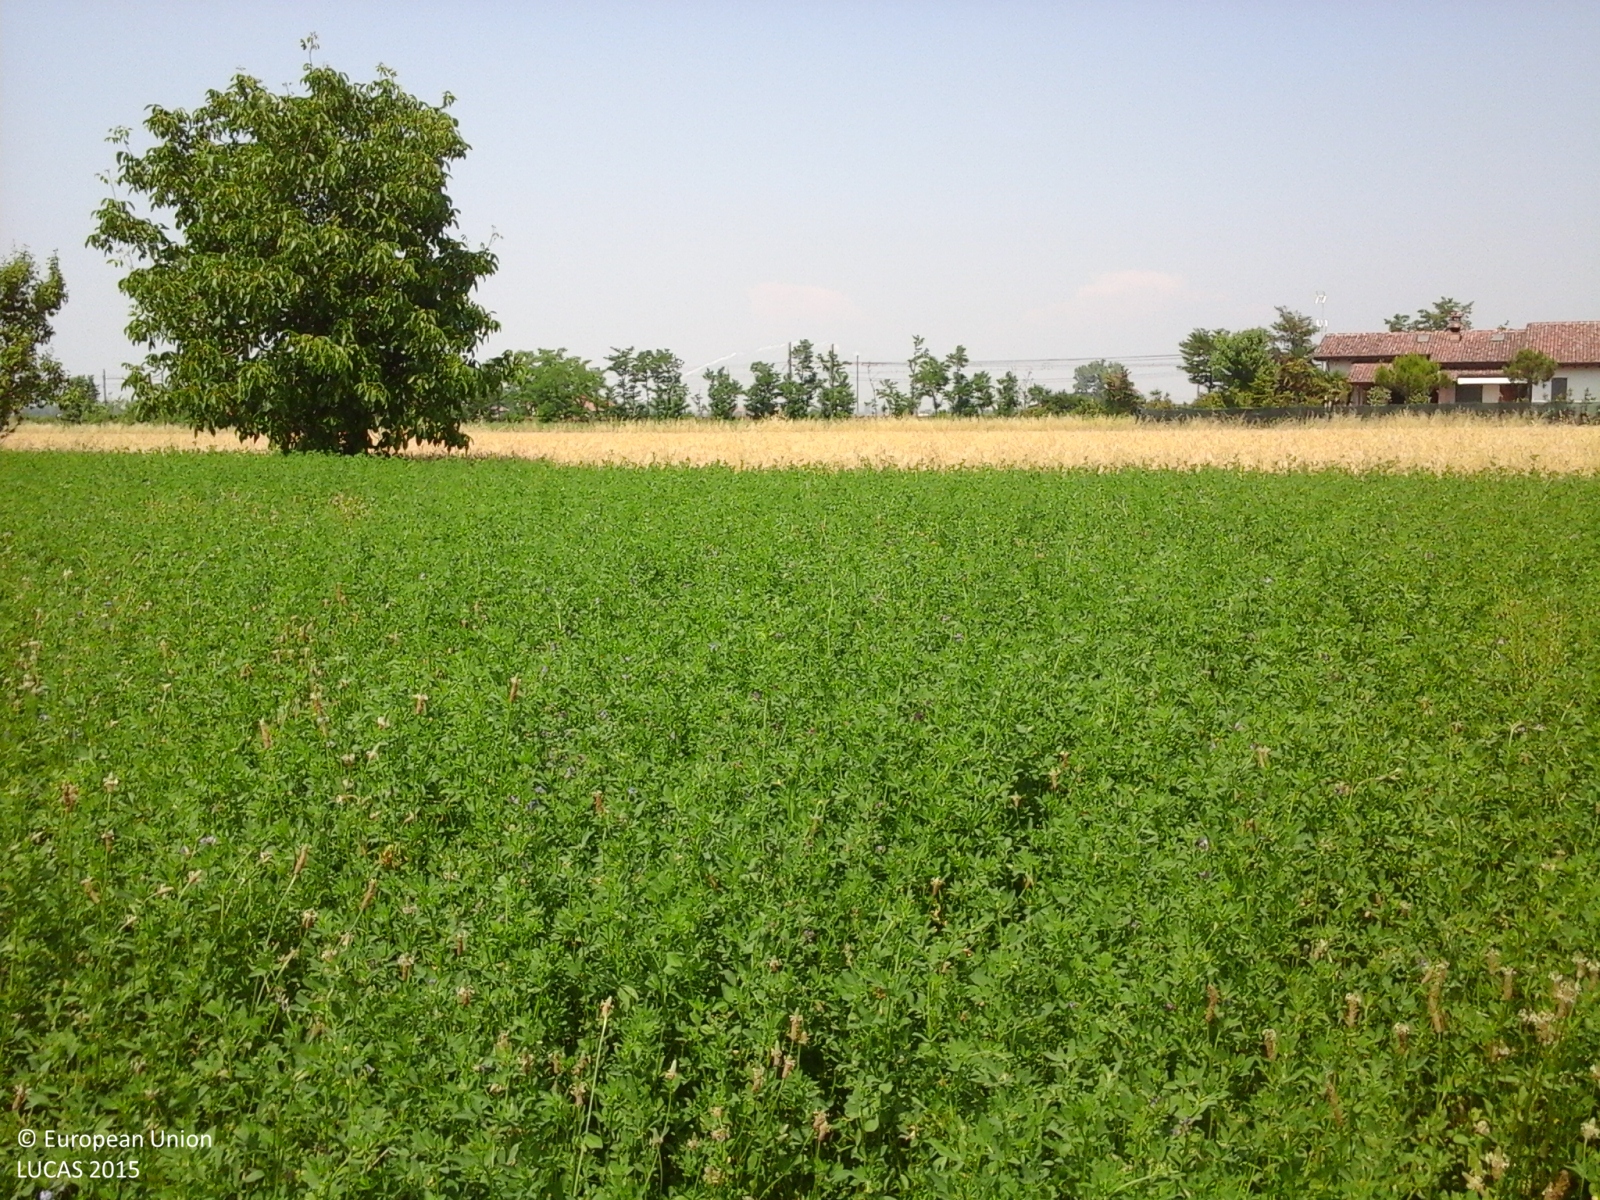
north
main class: Cropland
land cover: Lucerne
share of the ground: > 75 %
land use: Agriculture (excluding fallow land and kitchen gardens)
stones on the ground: < 10 %
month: June
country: IT
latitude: 44.9456
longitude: 9.8862
